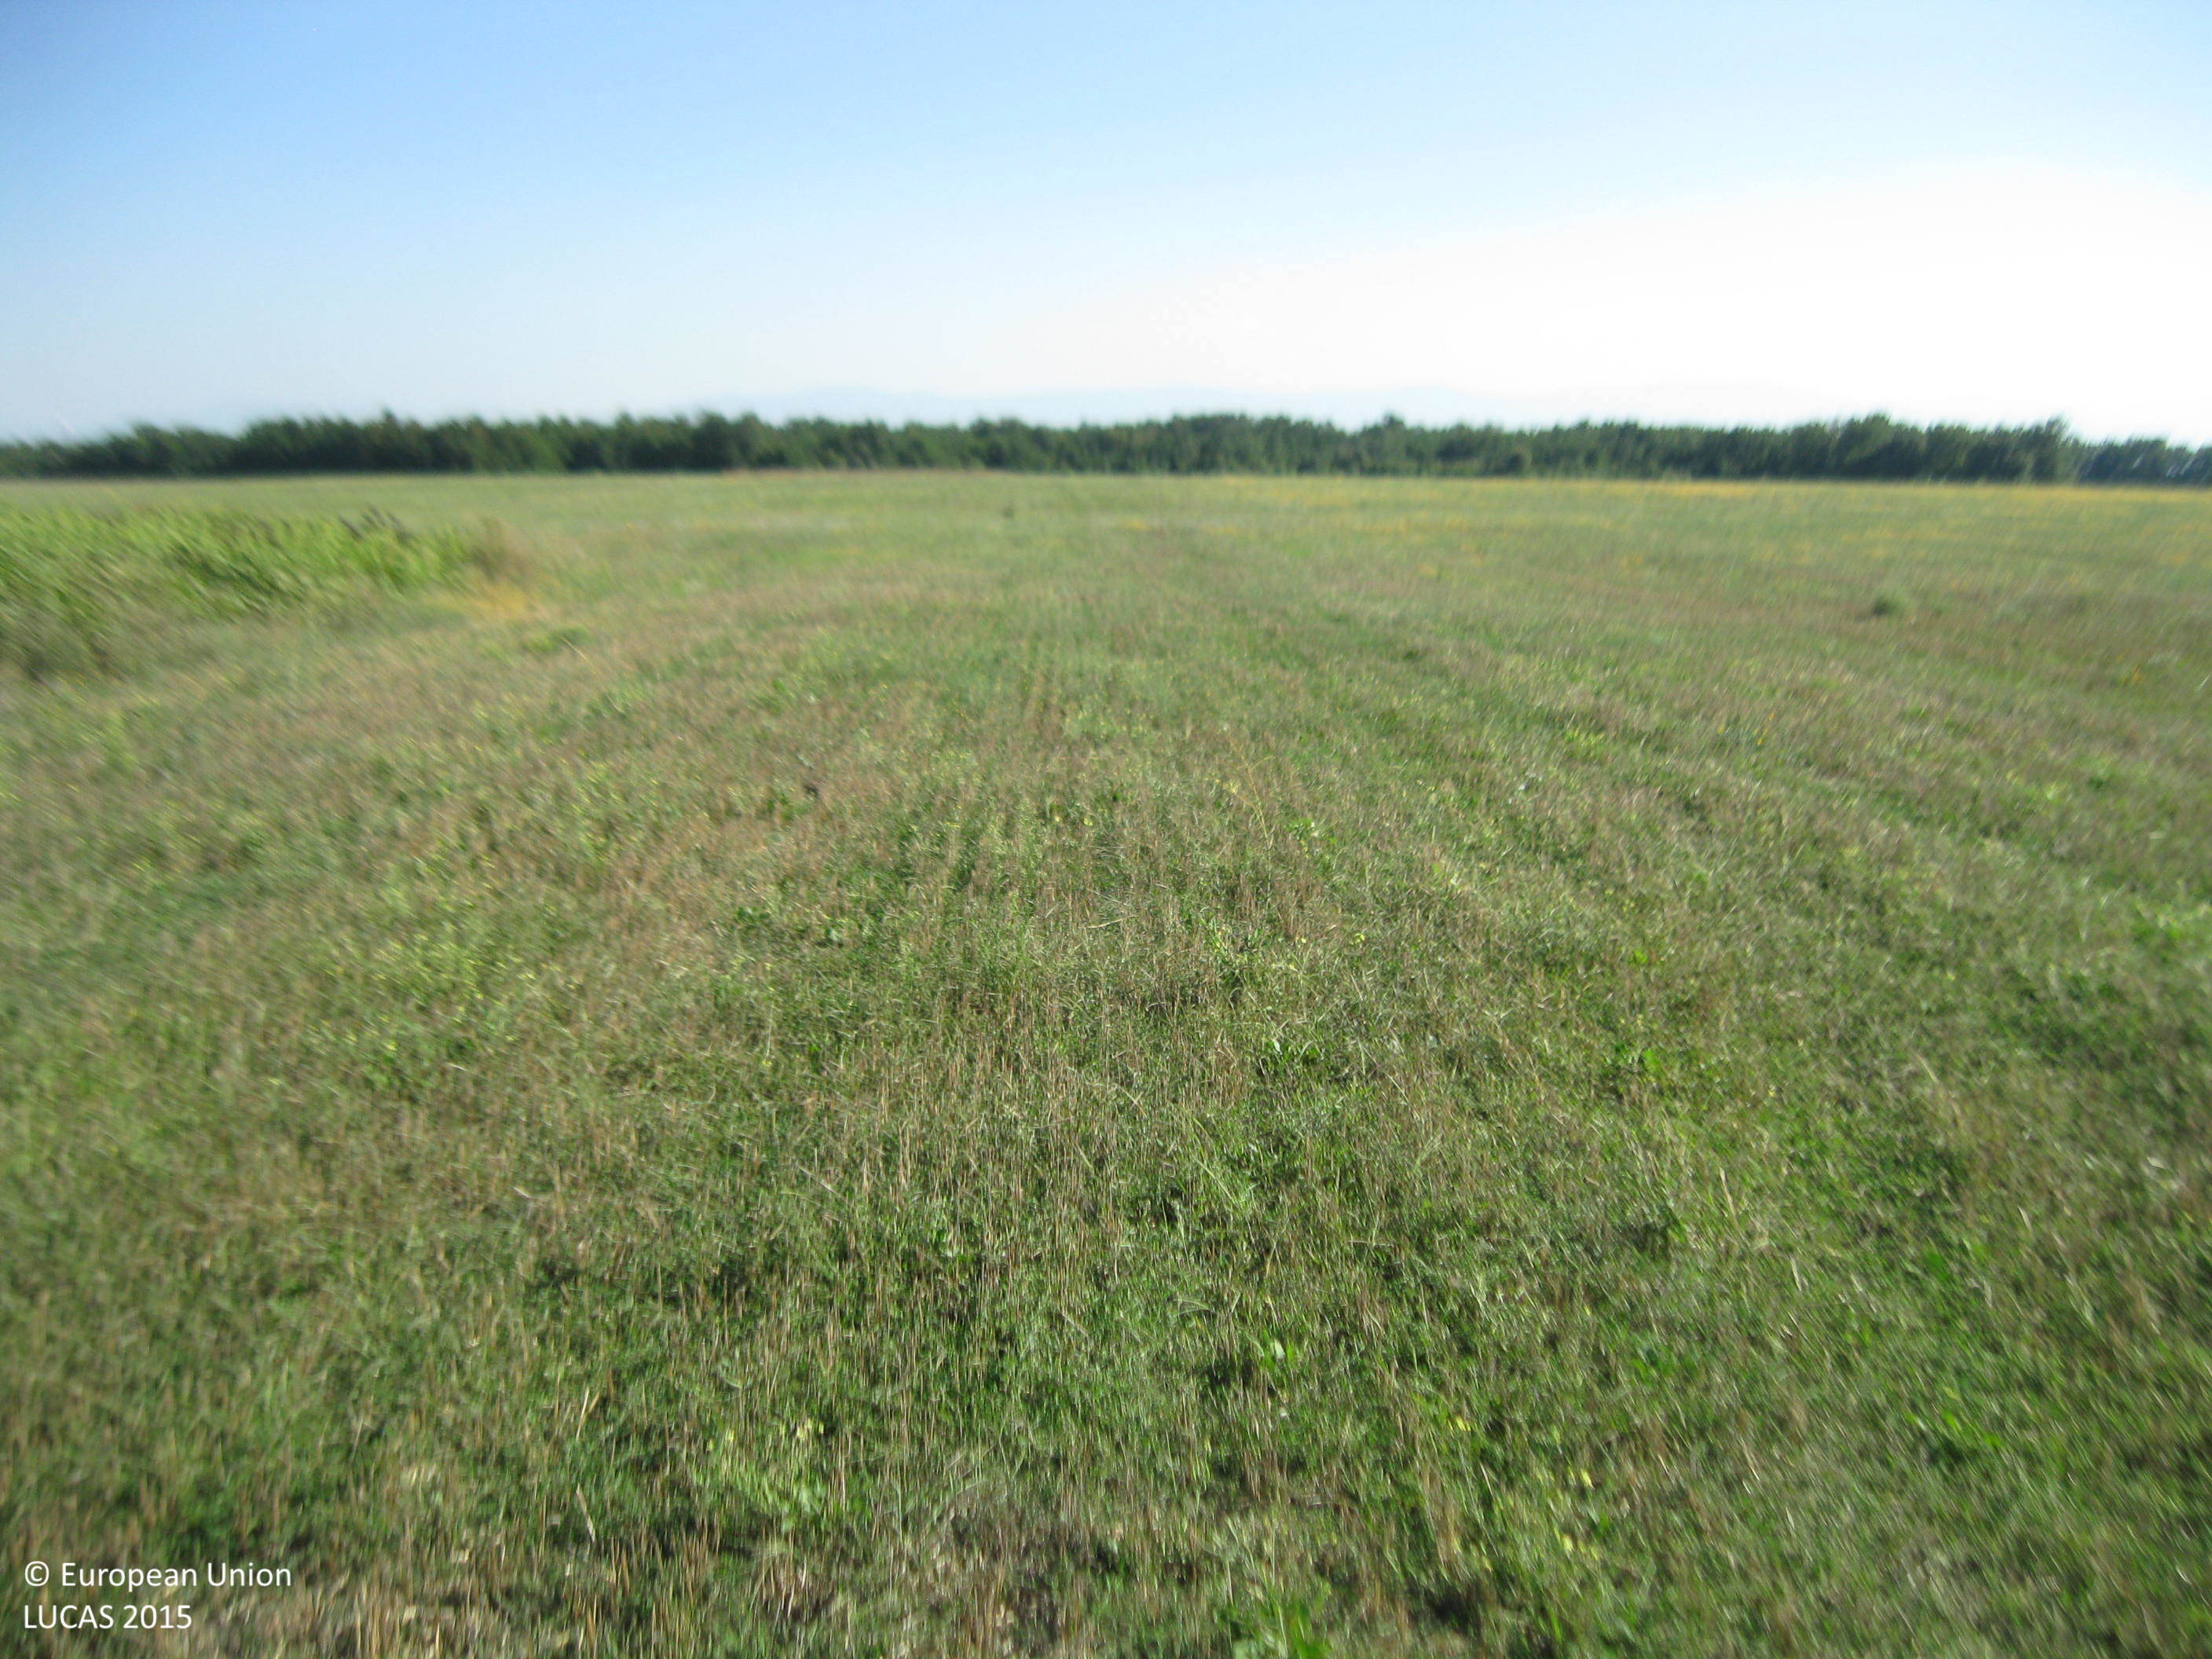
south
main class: Cropland
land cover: Common wheat
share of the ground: 10 - 25 %
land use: Agriculture (excluding fallow land and kitchen gardens)
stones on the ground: < 10 %
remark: Harvested field
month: September
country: BG
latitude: 42.2520
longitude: 24.7059
